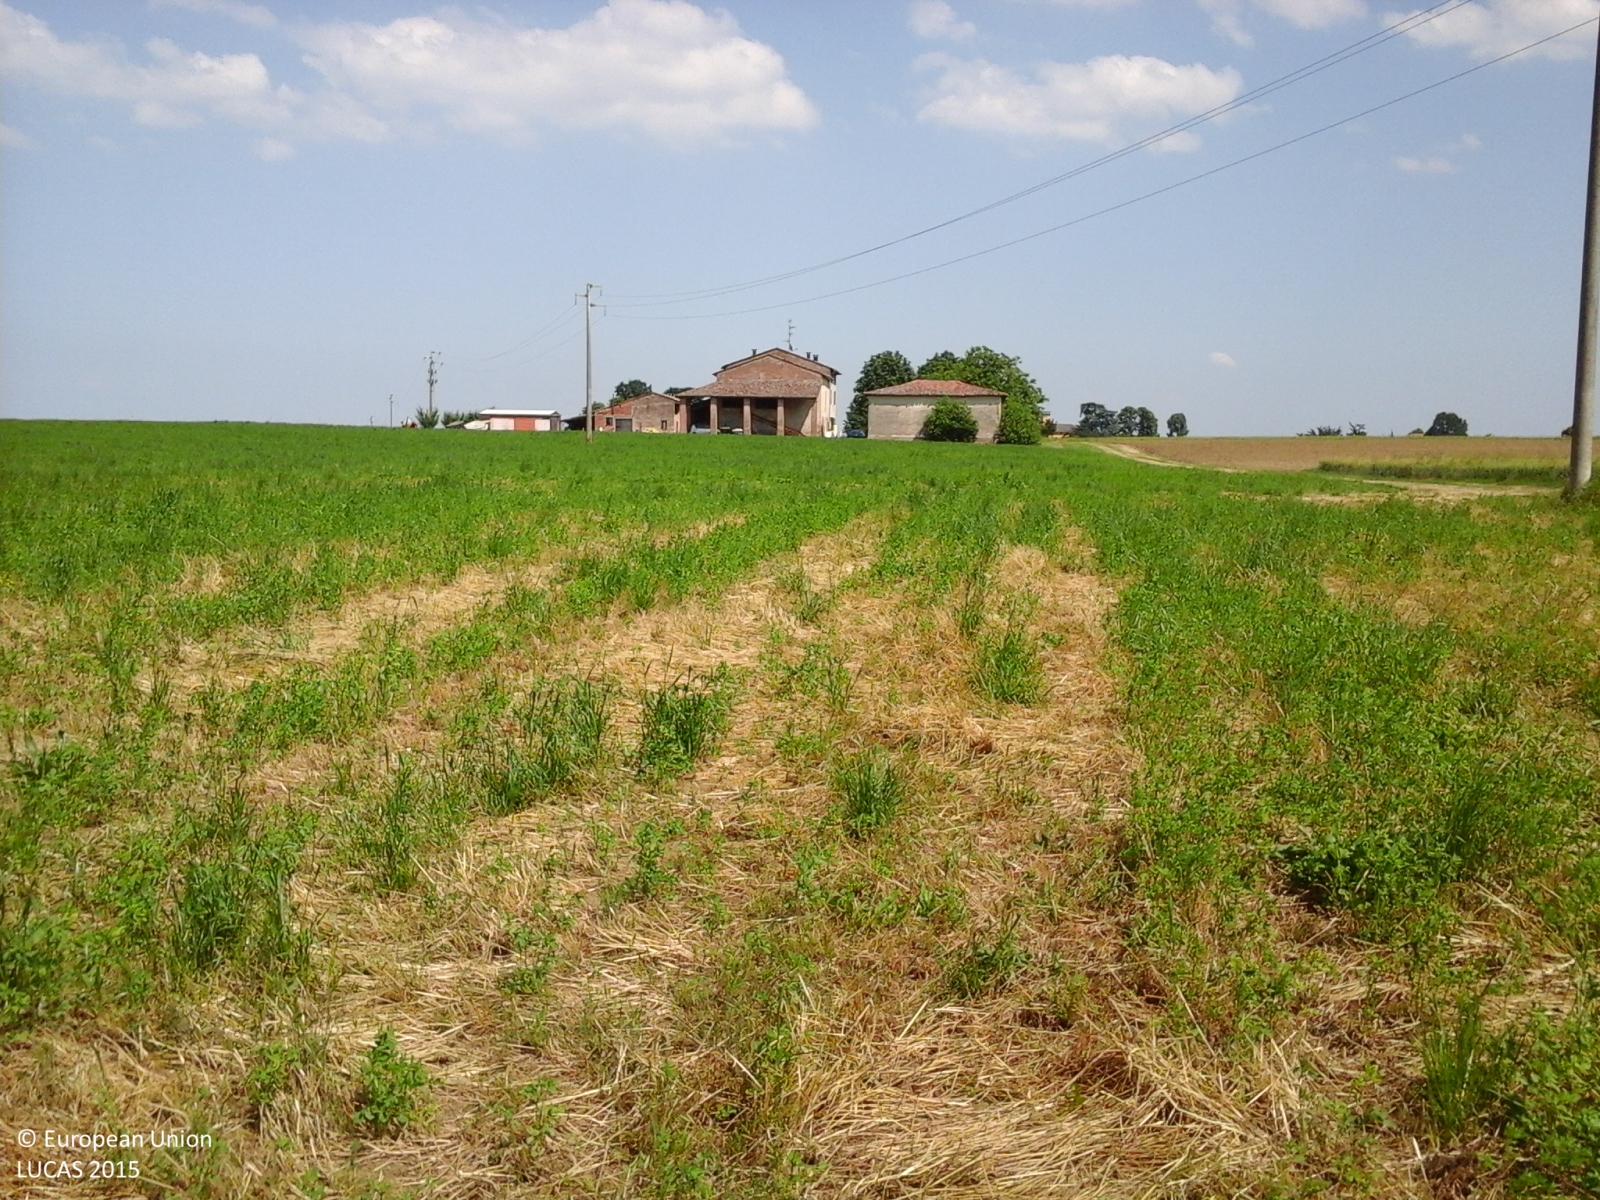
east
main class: Cropland
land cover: Lucerne
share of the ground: > 75 %
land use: Agriculture (excluding fallow land and kitchen gardens)
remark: Harvested field
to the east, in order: Lucerne; Electric lines; Lucerne; Artificial constructions in urban areas; Grassland without tree/shrub cover; Tracks; Grass margins; Ditches and canals; Common wheat; Ditches and canals; Barley
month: May
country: IT
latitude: 44.8013
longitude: 10.1640
